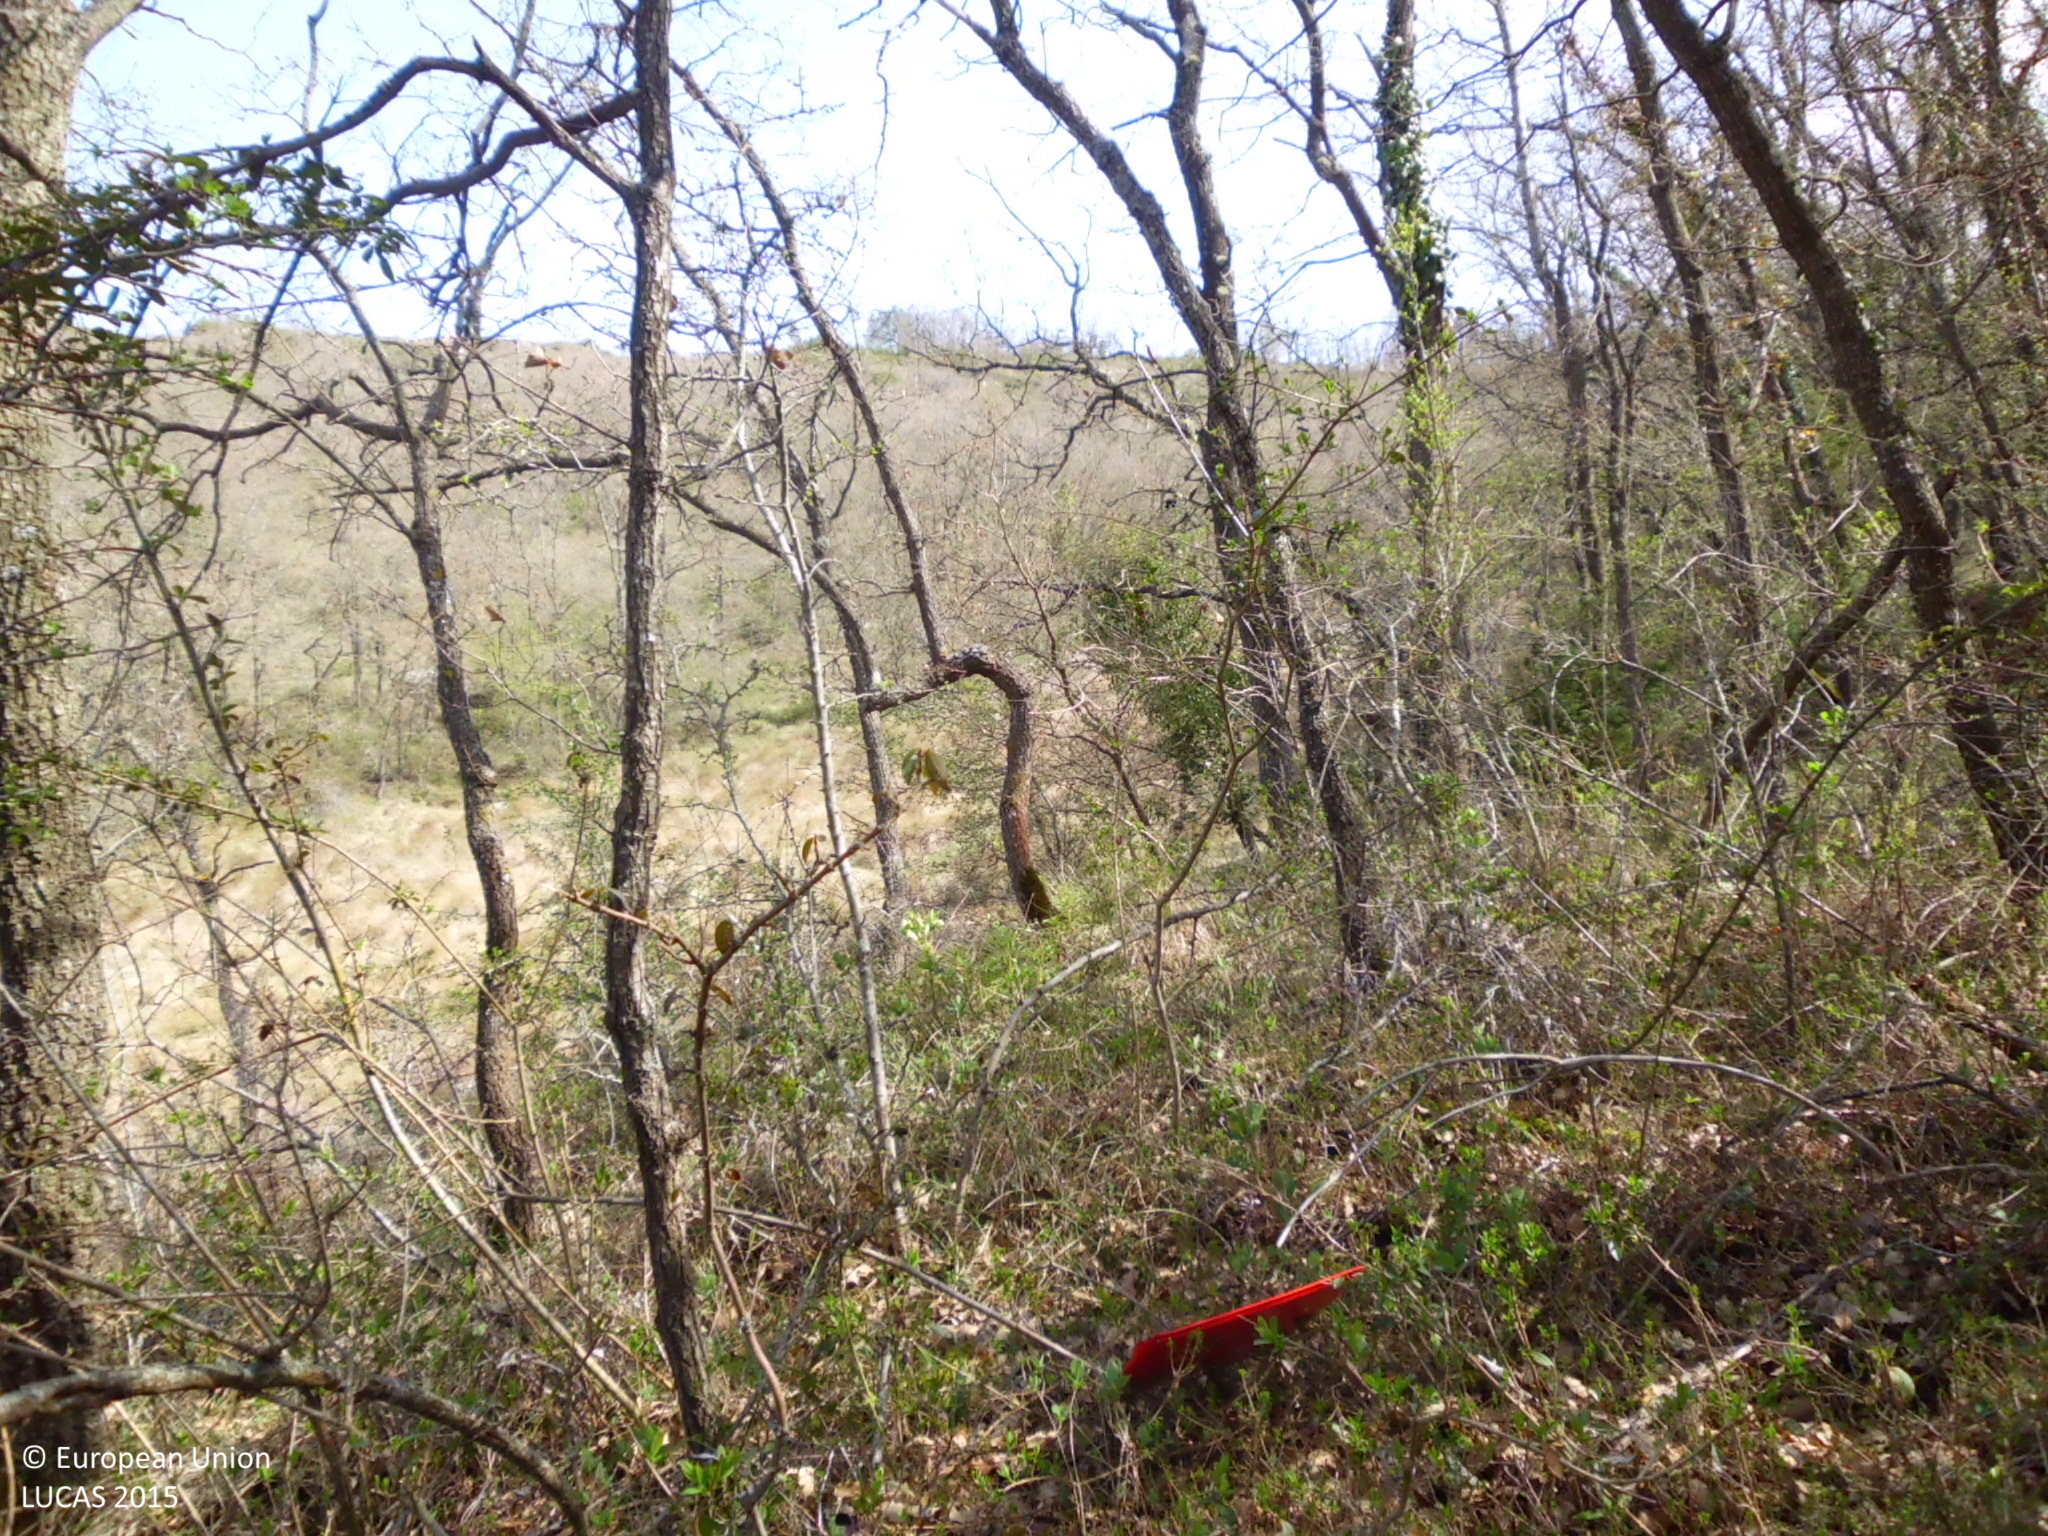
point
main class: Woodland
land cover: Broadleaved woodland
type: acidophilous oak and oak-birch forest
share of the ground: > 75 %
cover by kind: broadleaved forest trees 90 %, shrubs 10 %
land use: Semi-natural and natural areas not in use
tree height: > 5 m
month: April
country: ES
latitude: 42.5816
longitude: -3.4005
